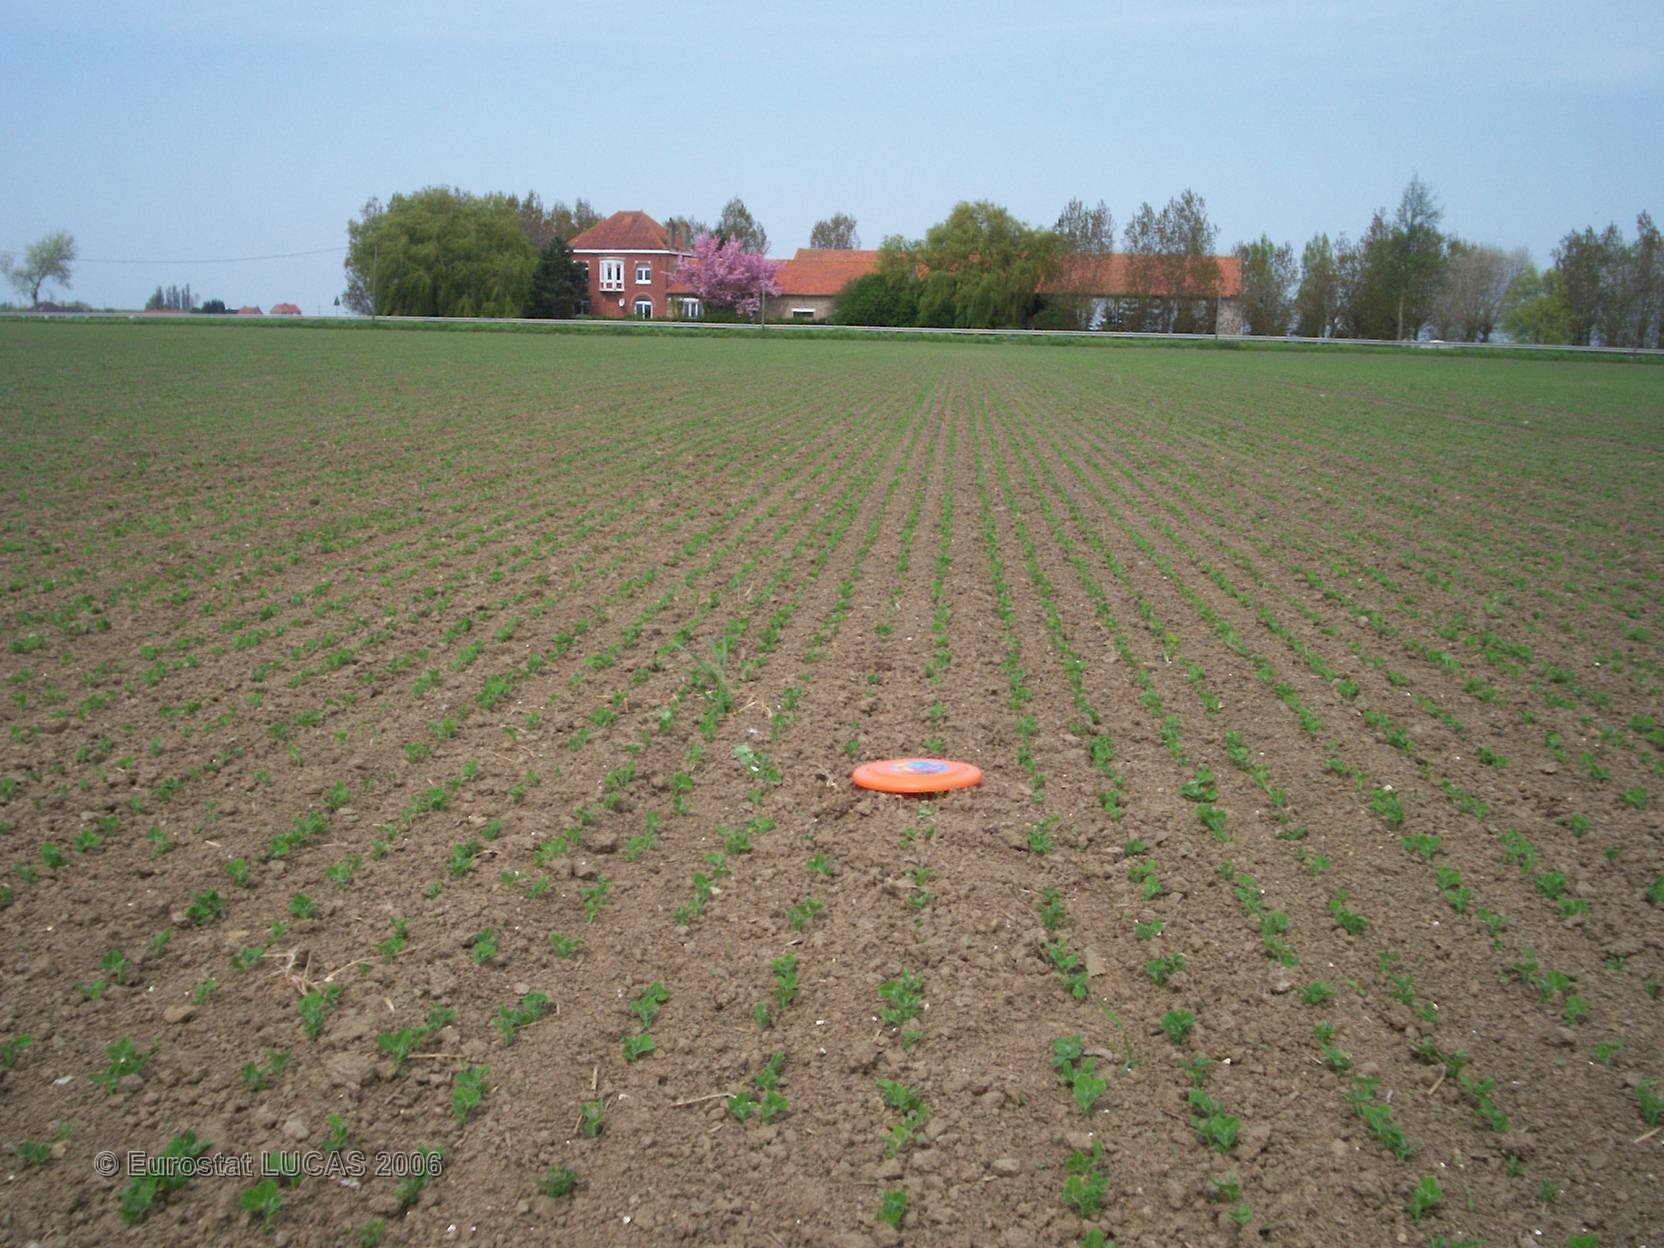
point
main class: Cropland
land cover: Dry pulses
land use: Agriculture (excluding fallow land and kitchen gardens)
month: May
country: FR
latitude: 50.9869
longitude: 2.5369
